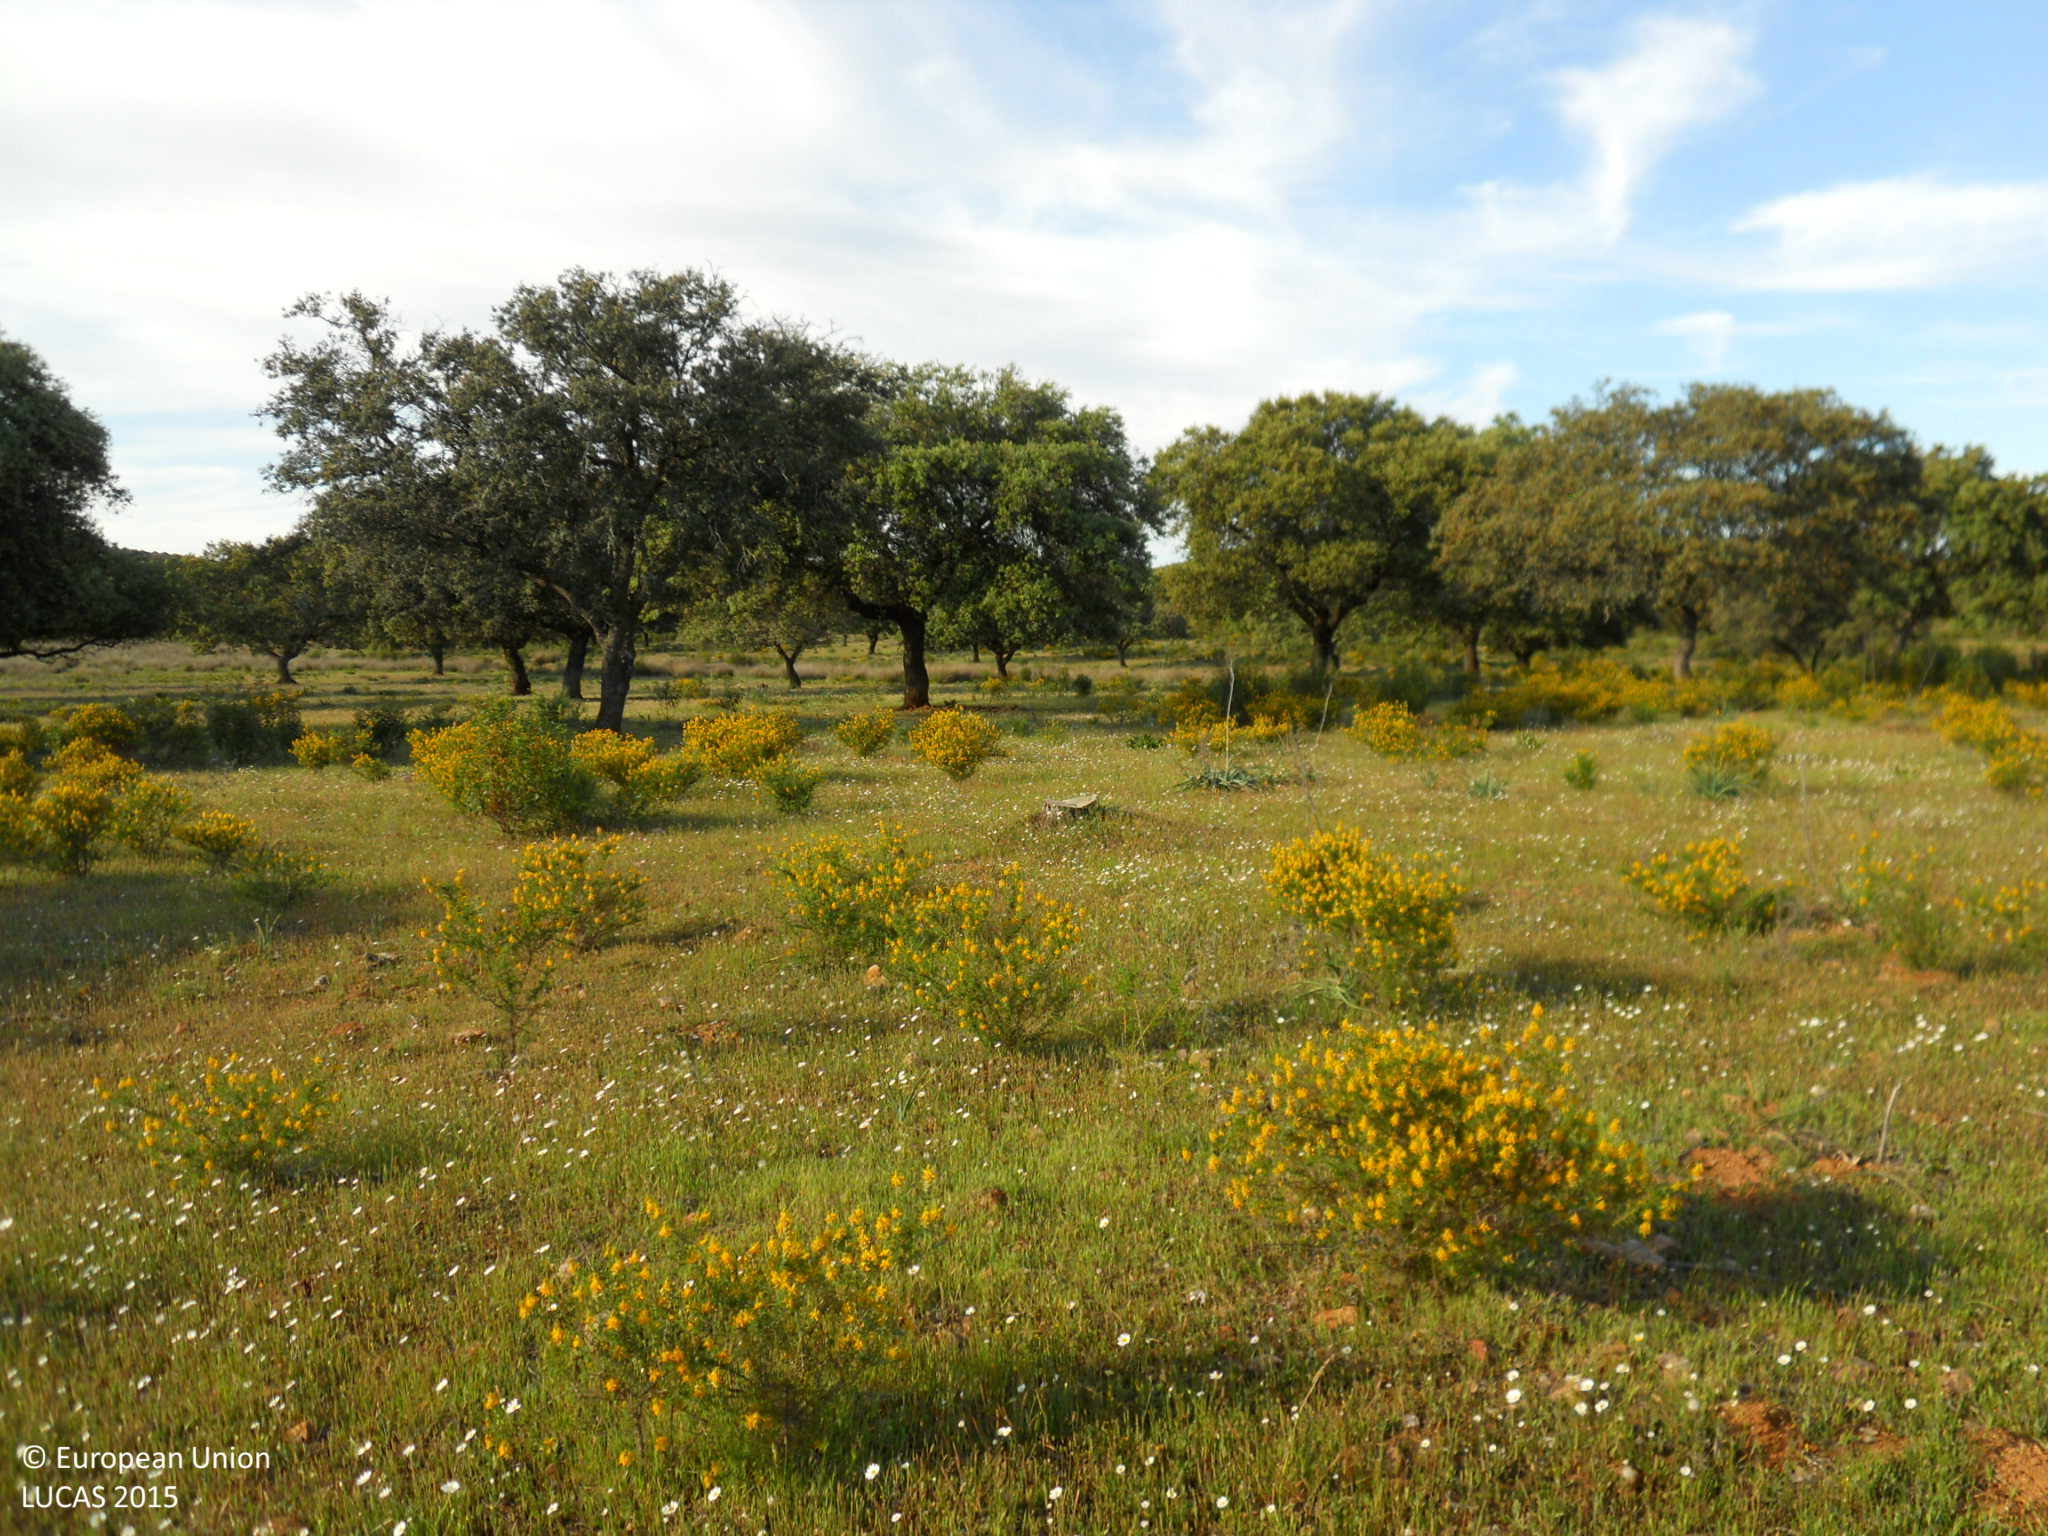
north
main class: Woodland
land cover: Broadleaved woodland
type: broadleaved evergreen forest
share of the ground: 50 - 75 %
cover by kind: broadleaved forest trees 70 %, herbaceous plants 20 %, shrubs 10 %
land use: Forestry
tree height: > 5 m
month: April
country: ES
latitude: 39.3562
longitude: -6.8214
